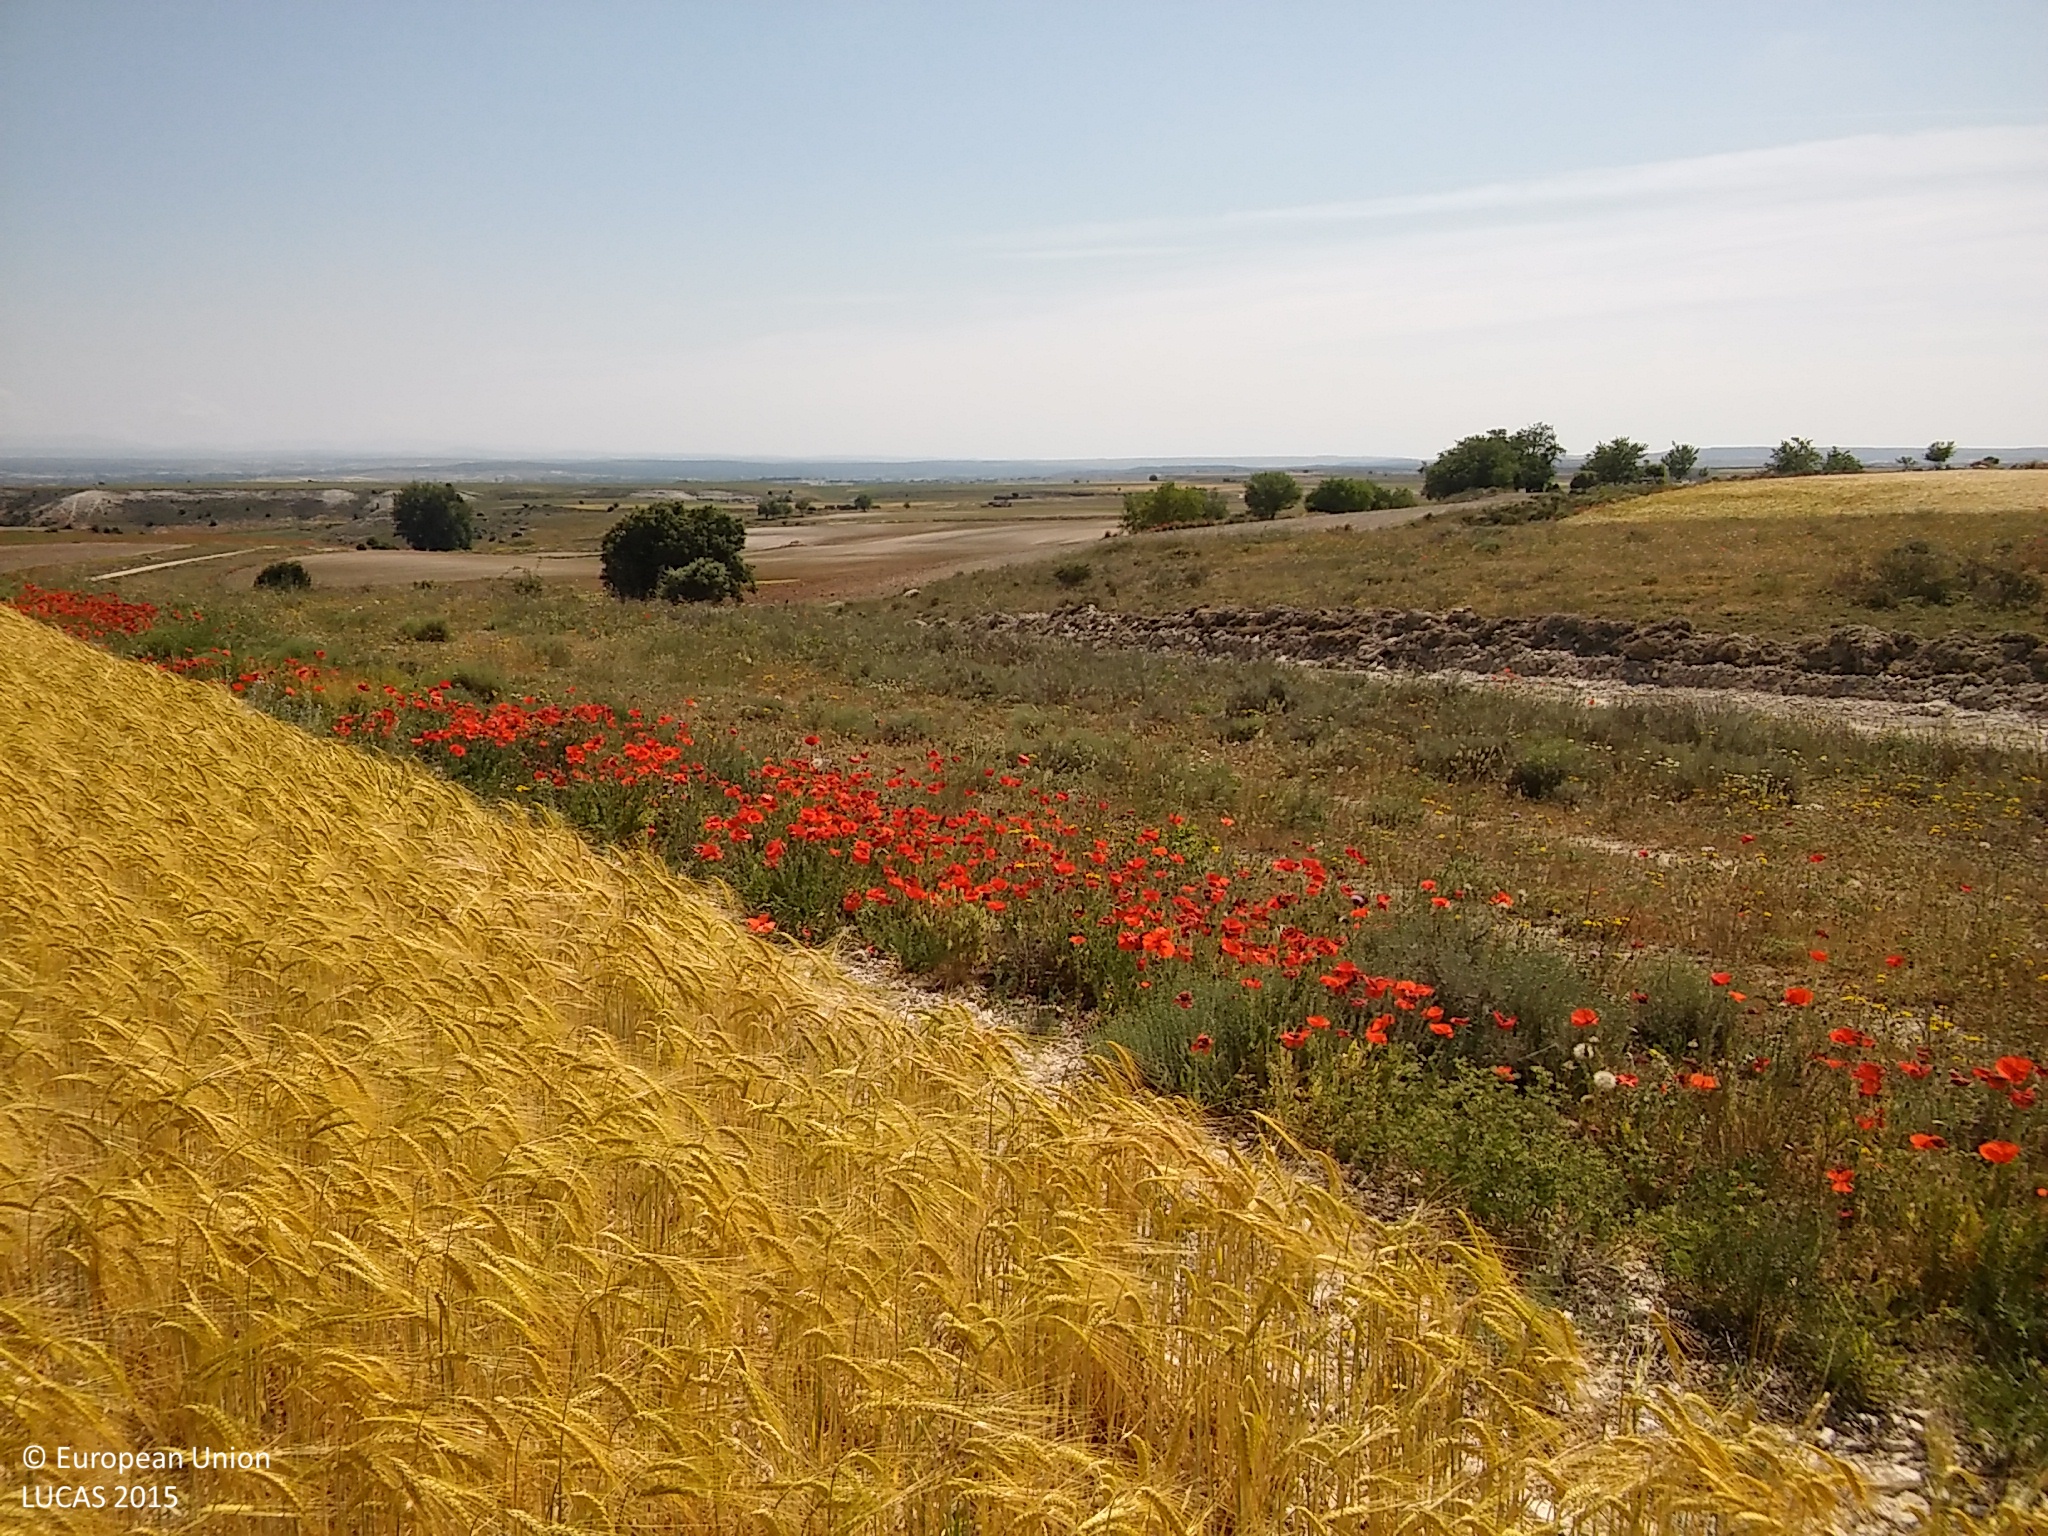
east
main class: Cropland
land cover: Barley
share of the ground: > 75 %
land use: Agriculture (excluding fallow land and kitchen gardens)
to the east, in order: Barley; Shrubland without tree cover; Tracks; Shrubland without tree cover; Grassland without tree/shrub cover; Other bare soil; Groves; Other bare soil; Broadleaved woodland
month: June
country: ES
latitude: 41.6202
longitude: -3.7470
